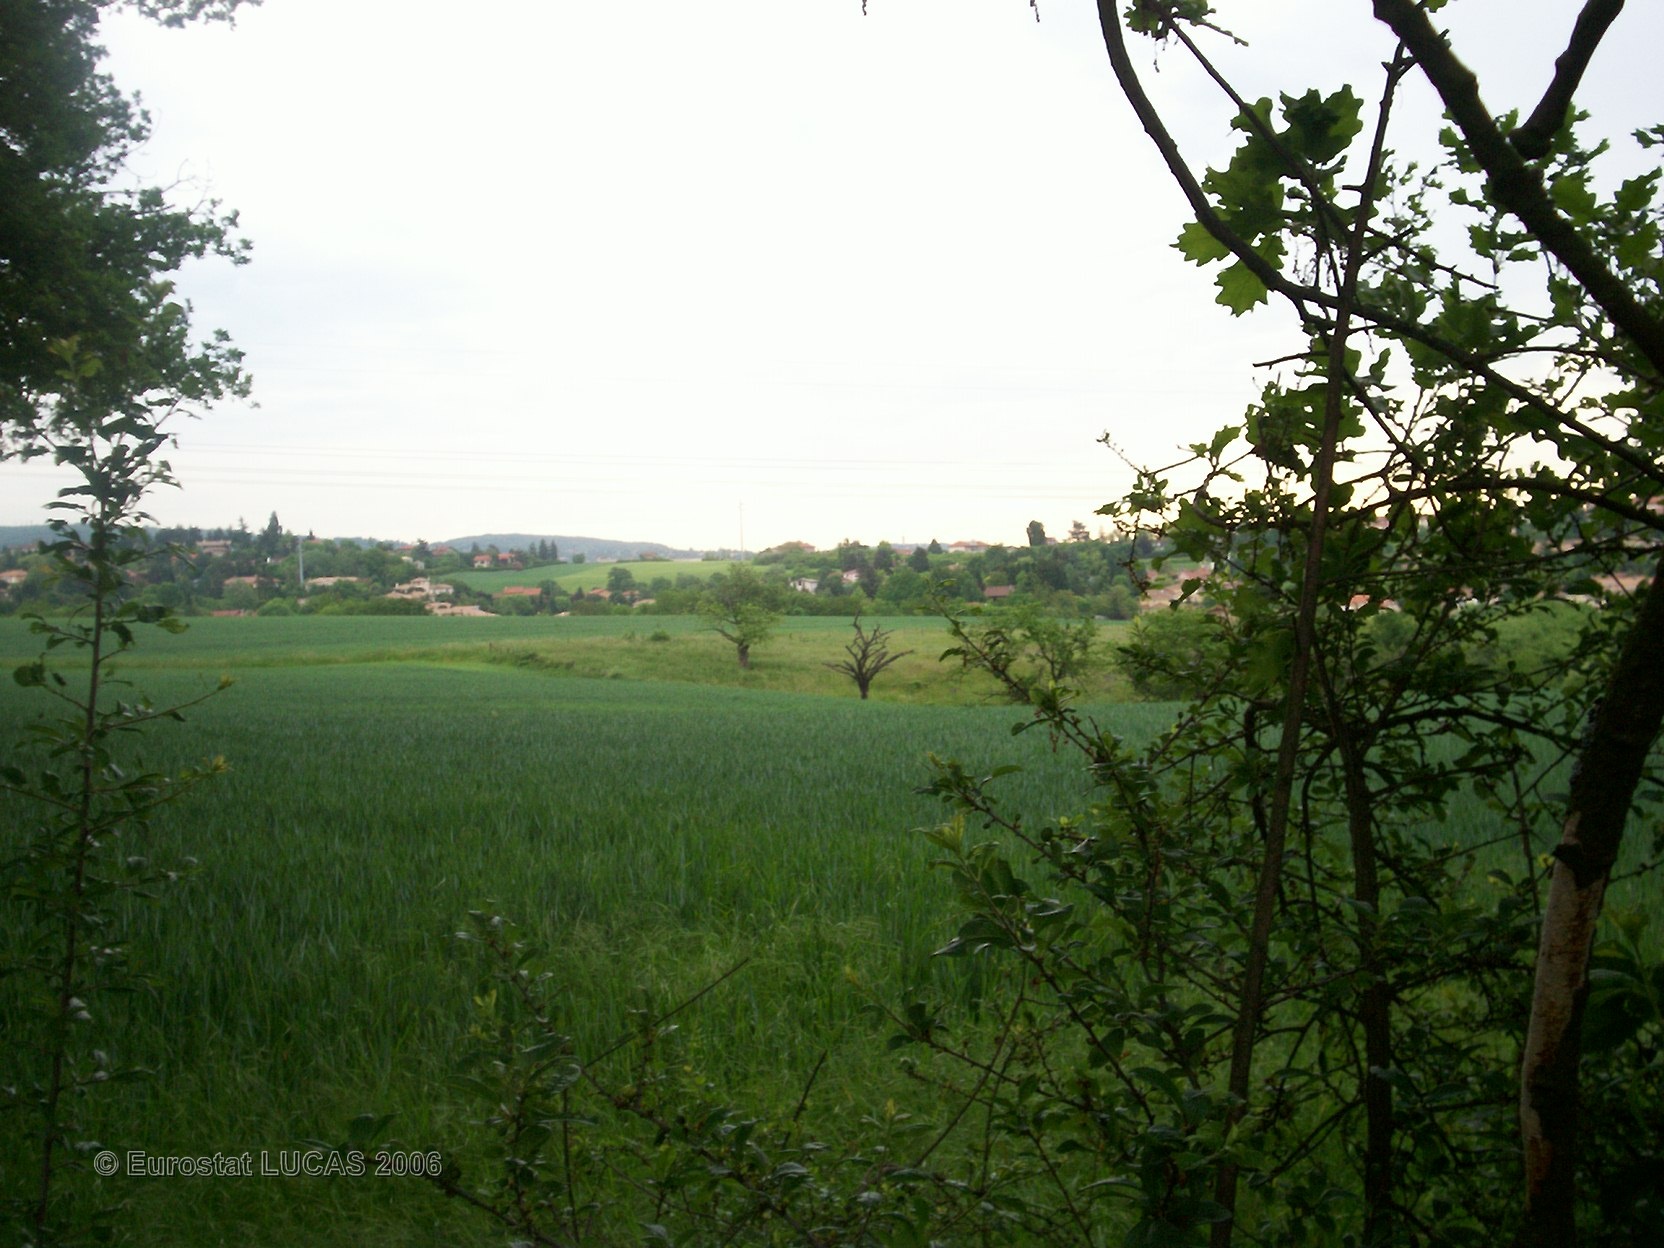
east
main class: Grassland
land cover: Grassland with sparse tree/shrub cover
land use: Residential
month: May
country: FR
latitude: 45.8067
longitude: 4.7404
